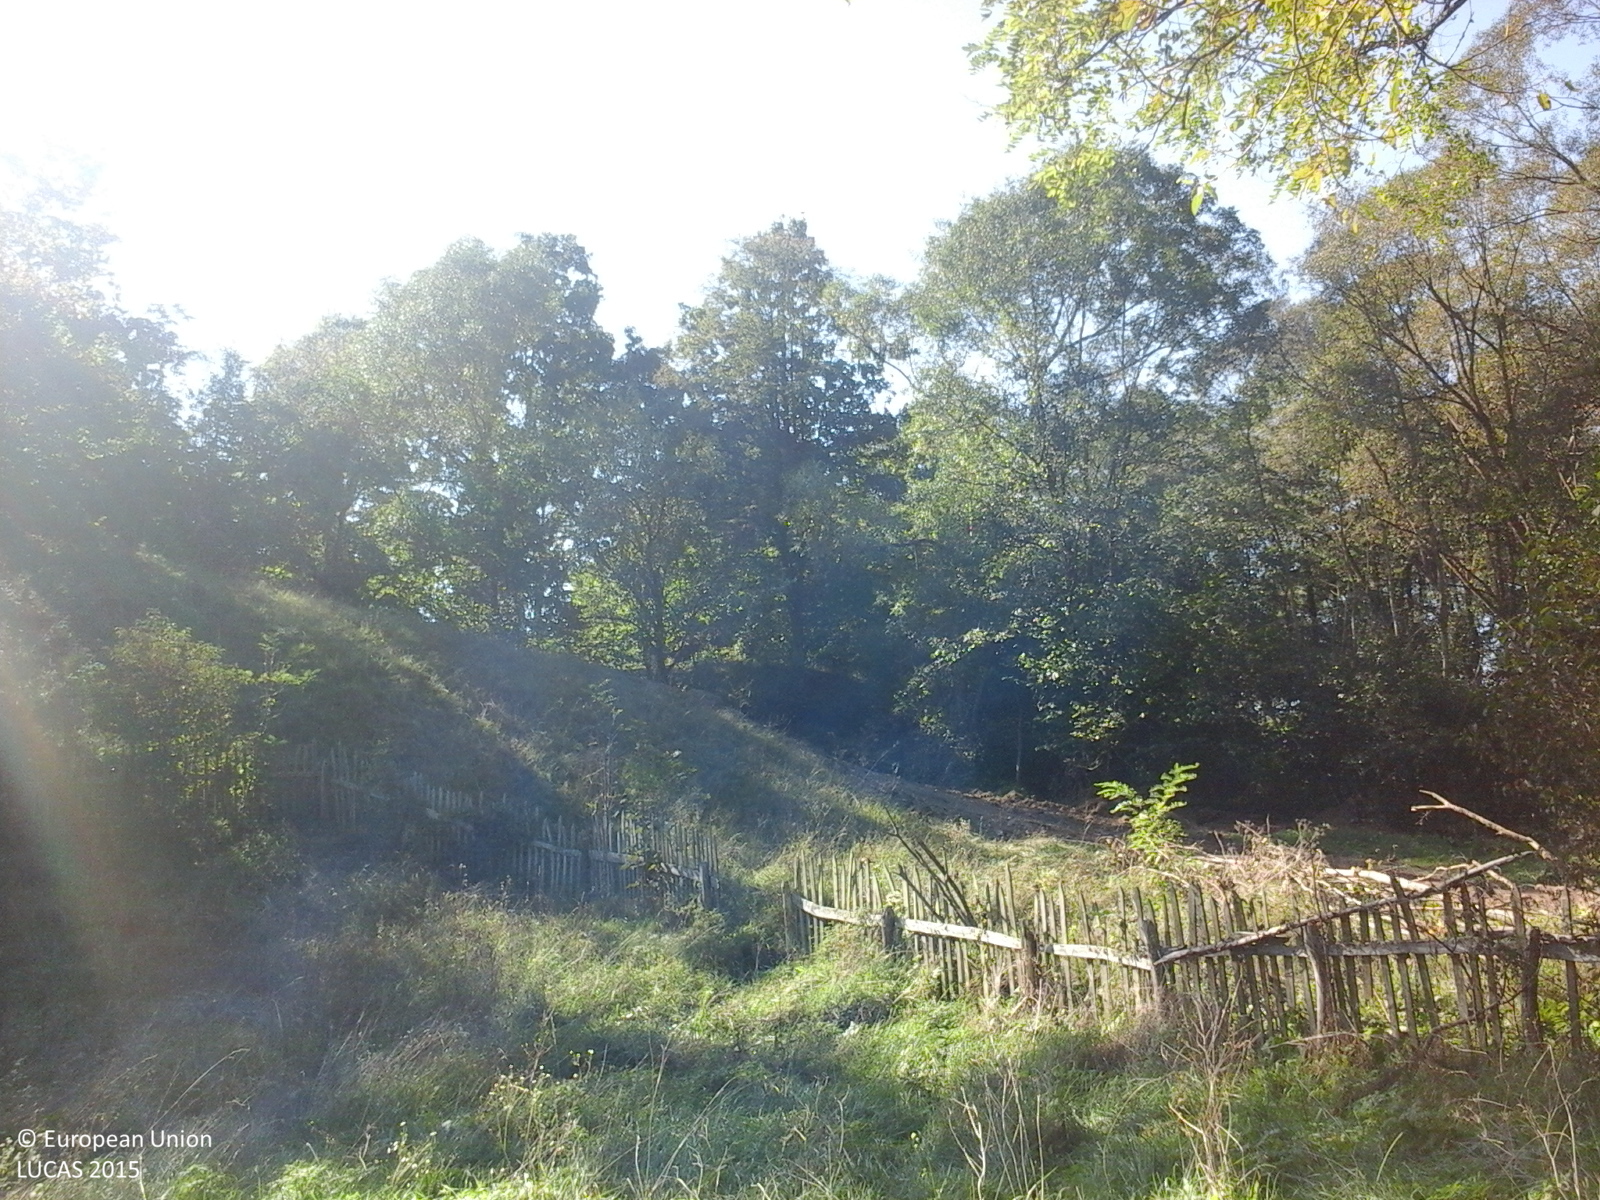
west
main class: Woodland
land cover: Broadleaved woodland
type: exotic forest
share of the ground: > 75 %
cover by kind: broadleaved forest trees 80 %, herbaceous plants 20 %
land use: Forestry
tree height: > 5 m
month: October
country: RO
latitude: 46.5120
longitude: 23.5050
